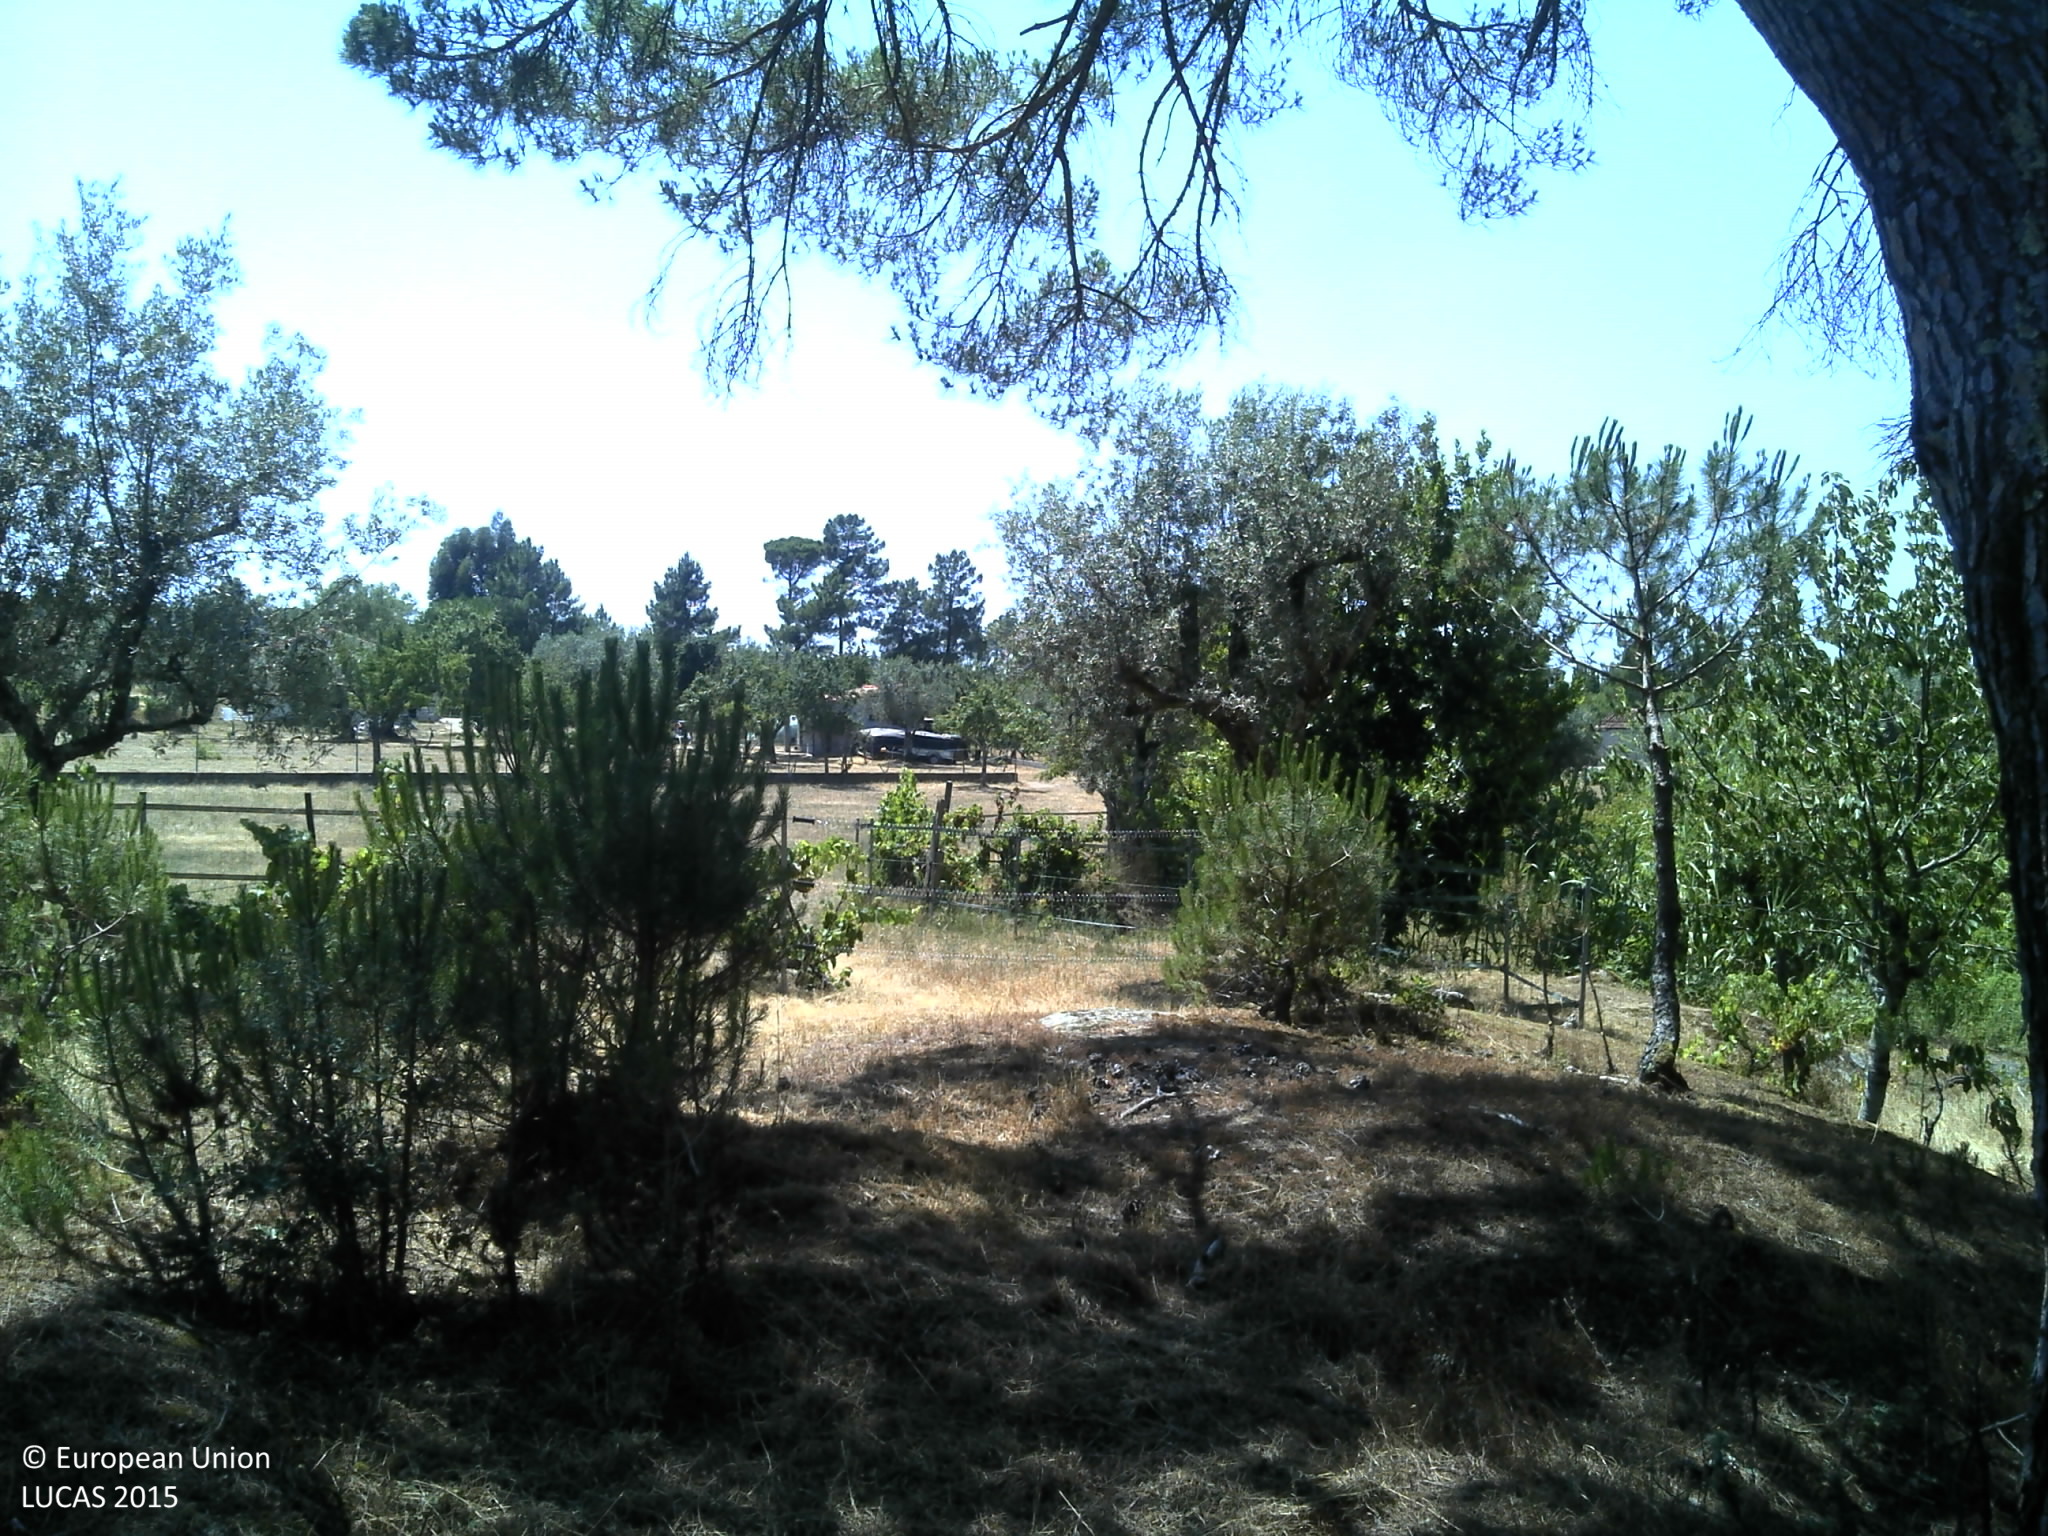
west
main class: Woodland
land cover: Pine dominated coniferous woodland
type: coniferous forest of the mediterranean region
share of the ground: 50 - 75 %
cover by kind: coniferous forest trees 60 %, unconsolidated bare surface 25 %, shrubs 10 %, herbaceous plants 5 %
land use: Forestry
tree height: > 5 m
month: July
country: PT
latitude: 40.3939
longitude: -7.9215
